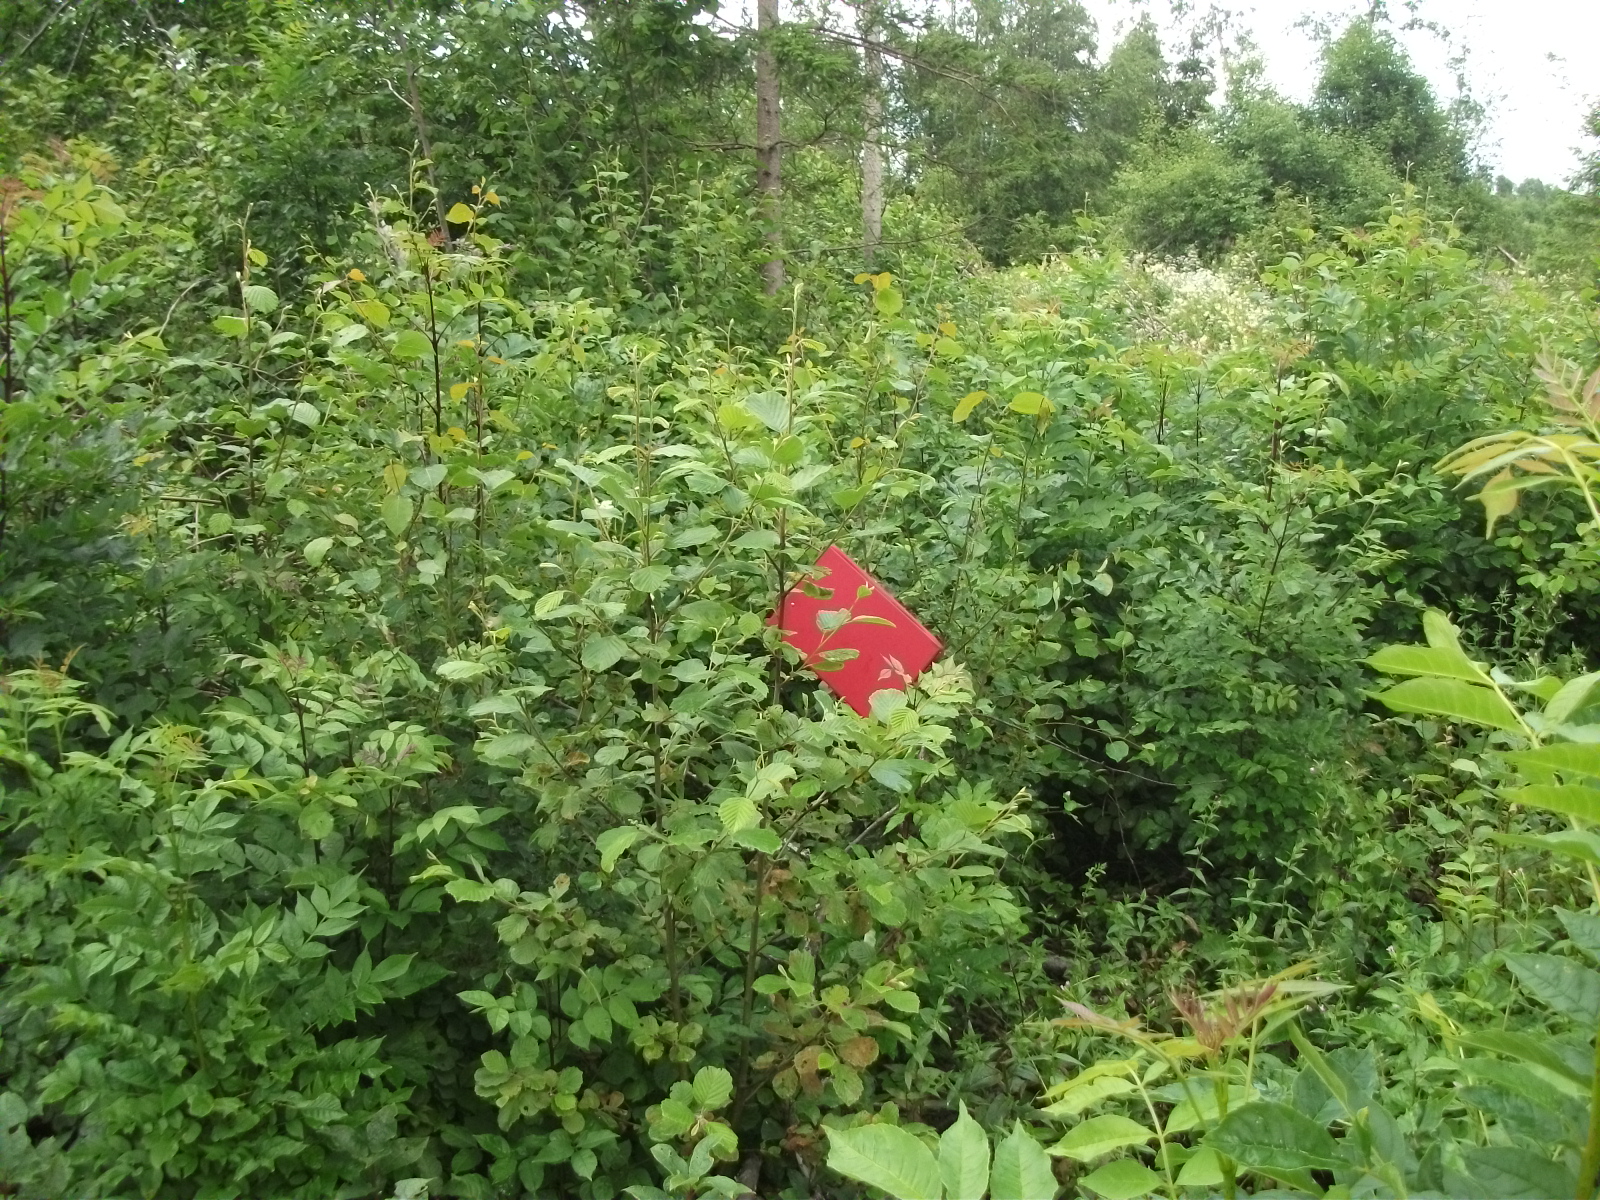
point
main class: Woodland
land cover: Broadleaved woodland
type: non-riverine alder, birch or aspen forest
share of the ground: 50 - 75 %
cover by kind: broadleaved forest trees 50 %, shrubs 40 %, herbaceous plants 10 %
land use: Forestry
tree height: < 5 m
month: July
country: LV
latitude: 56.9813
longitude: 26.2470
